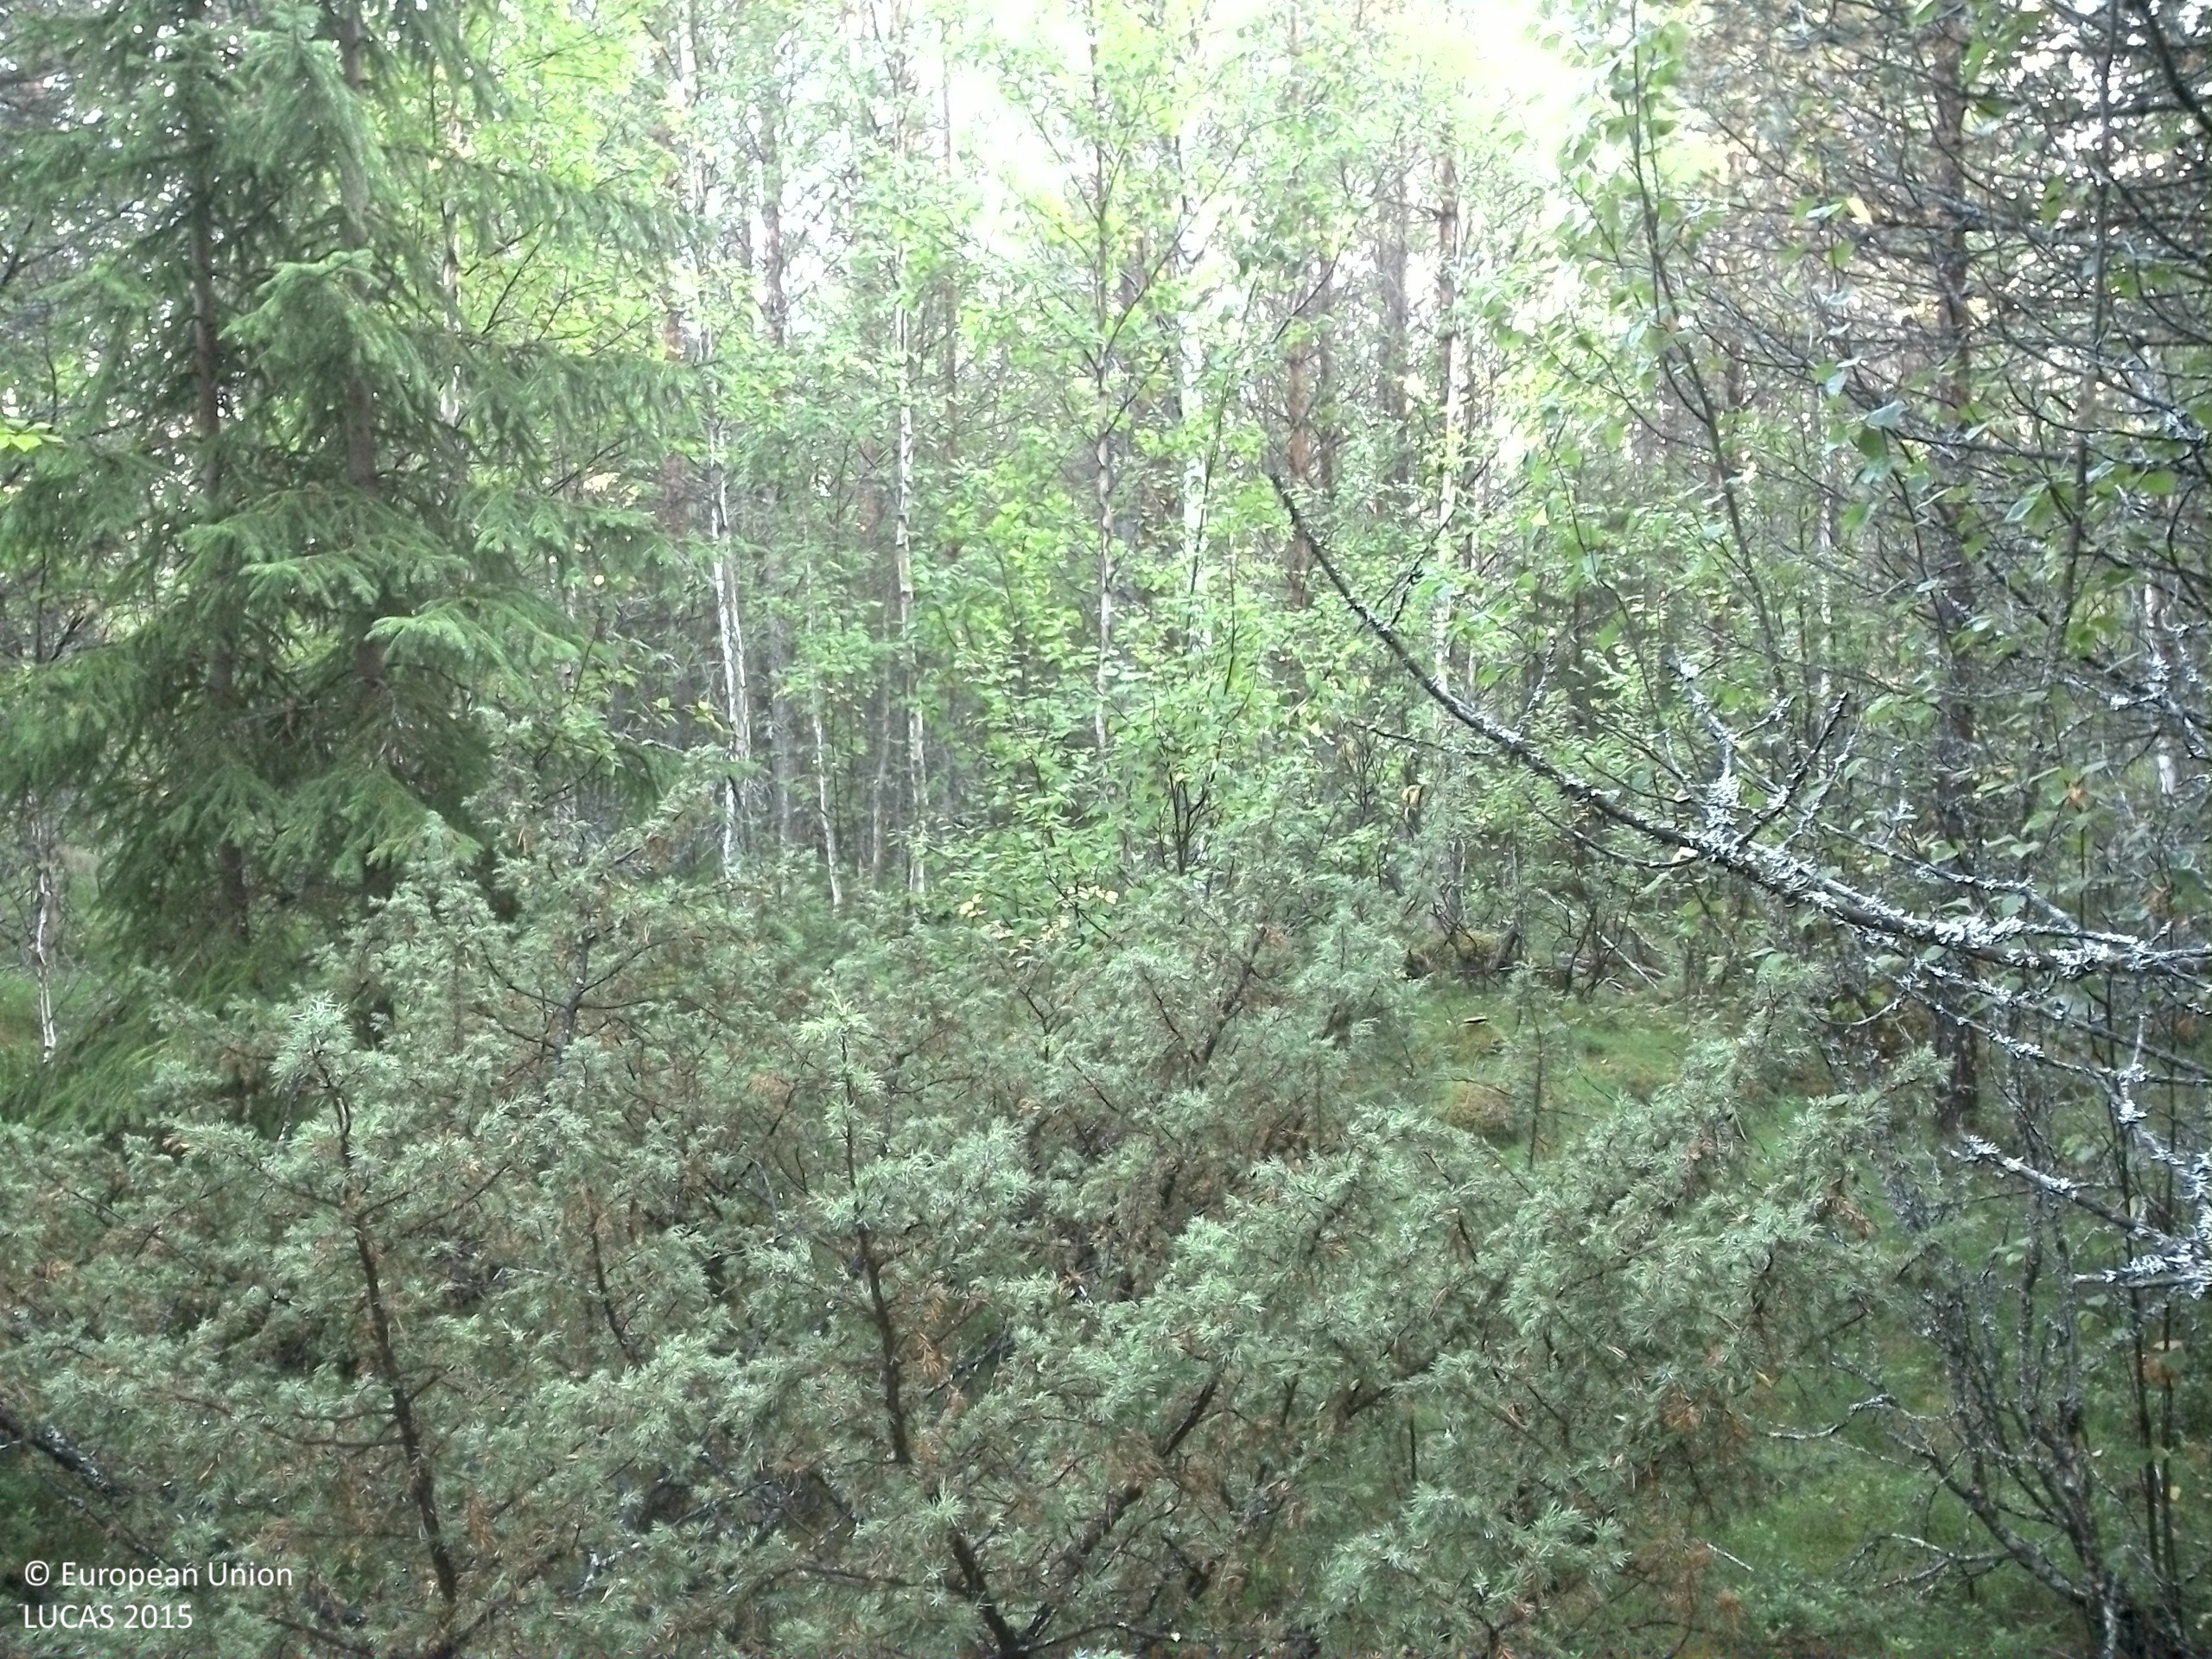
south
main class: Woodland
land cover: Pine dominated coniferous woodland
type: boreal forest
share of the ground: > 75 %
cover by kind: coniferous forest trees 80 %, shrubs 15 %, broadleaved forest trees 5 %
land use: Forestry
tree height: > 5 m
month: August
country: SE
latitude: 63.8665
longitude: 17.3174
